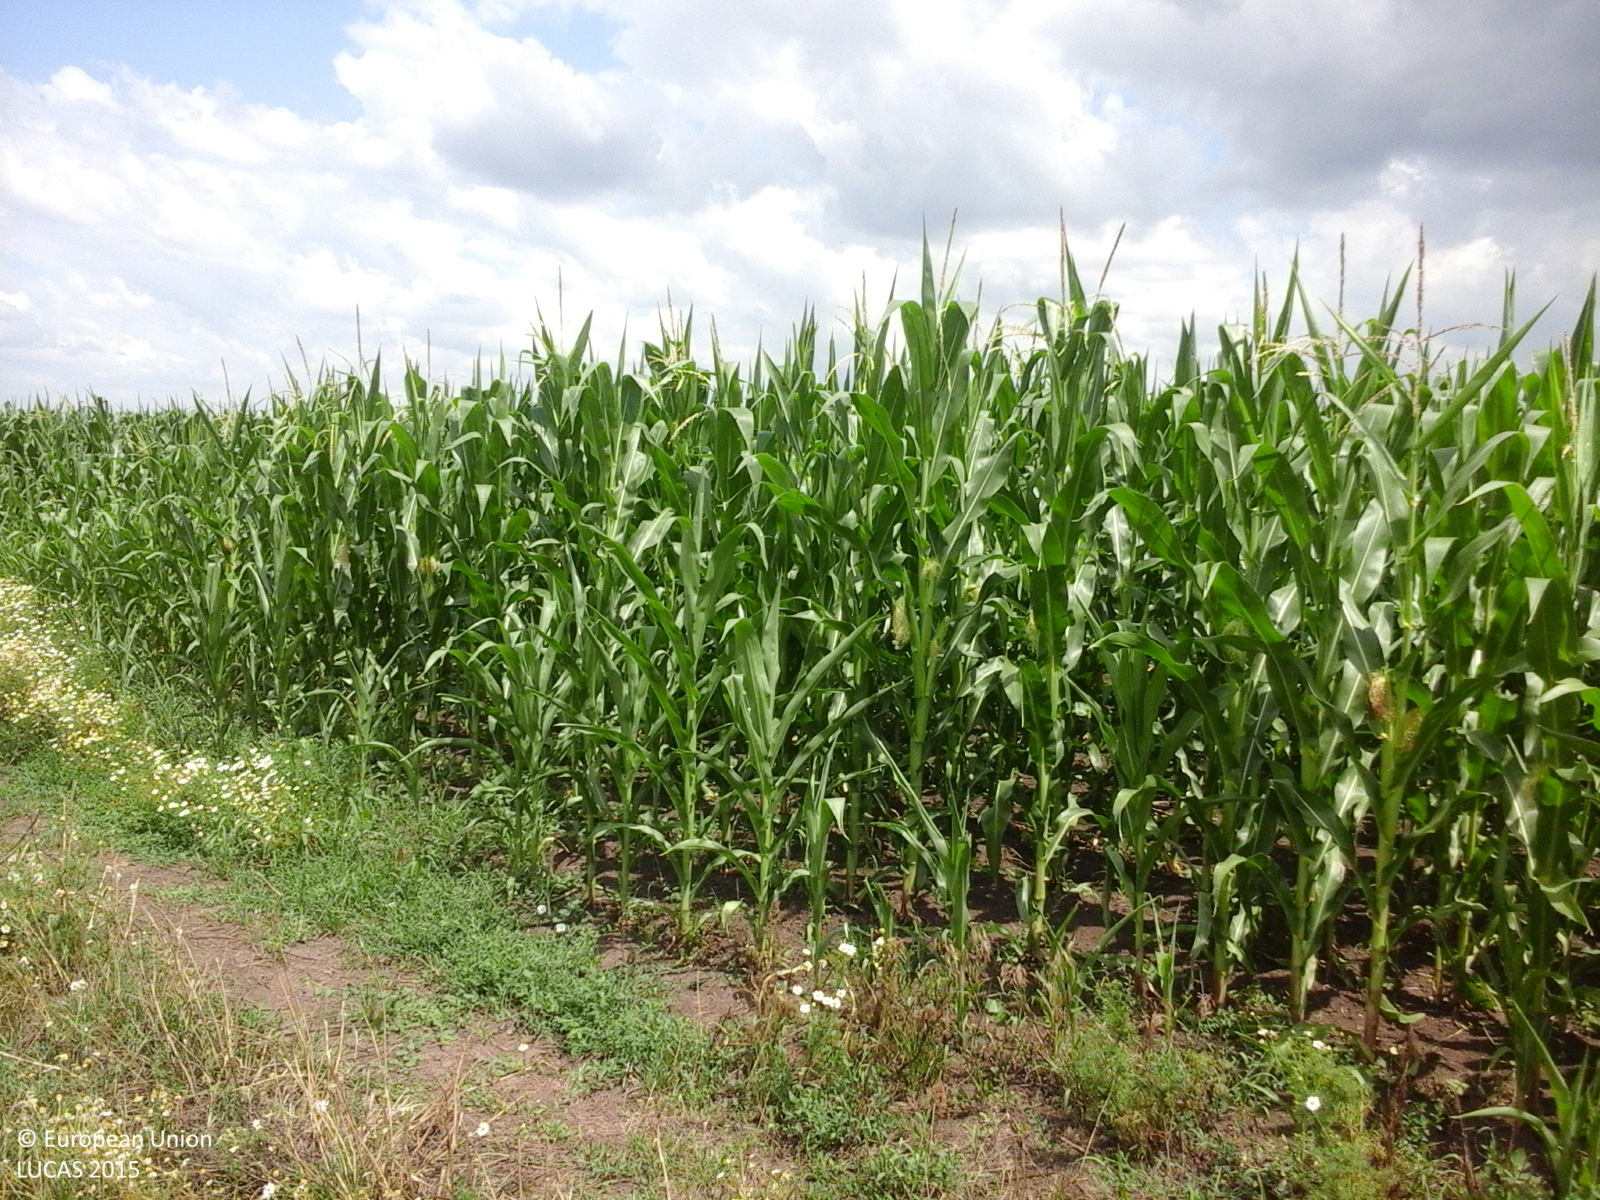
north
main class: Cropland
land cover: Maize
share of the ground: > 75 %
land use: Agriculture (excluding fallow land and kitchen gardens)
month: July
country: RO
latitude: 43.8966
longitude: 25.2308
